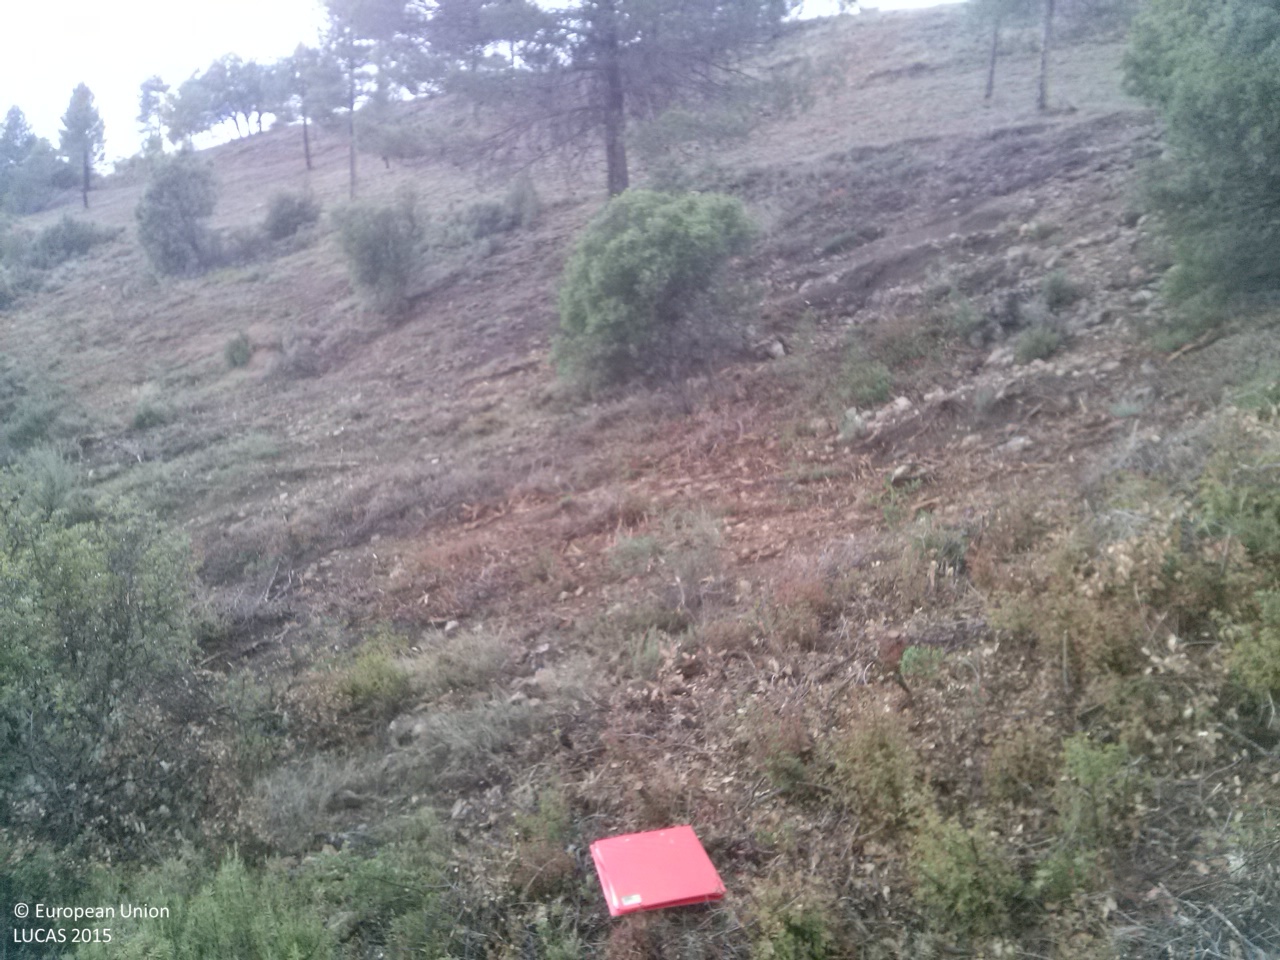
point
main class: Woodland
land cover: Other mixed woodland
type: broadleaved evergreen forest
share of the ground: 25 - 50 %
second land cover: Shrubland without tree cover
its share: 25 - 50 %
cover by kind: shrubs 35 %, broadleaved forest trees 25 %, unconsolidated bare surface 20 %, coniferous forest trees 10 %, herbaceous plants 10 %
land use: Forestry
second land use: Agriculture (excluding fallow land and kitchen gardens)
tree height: > 5 m
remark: Clear cut
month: June
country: ES
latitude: 39.8267
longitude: -1.7990
